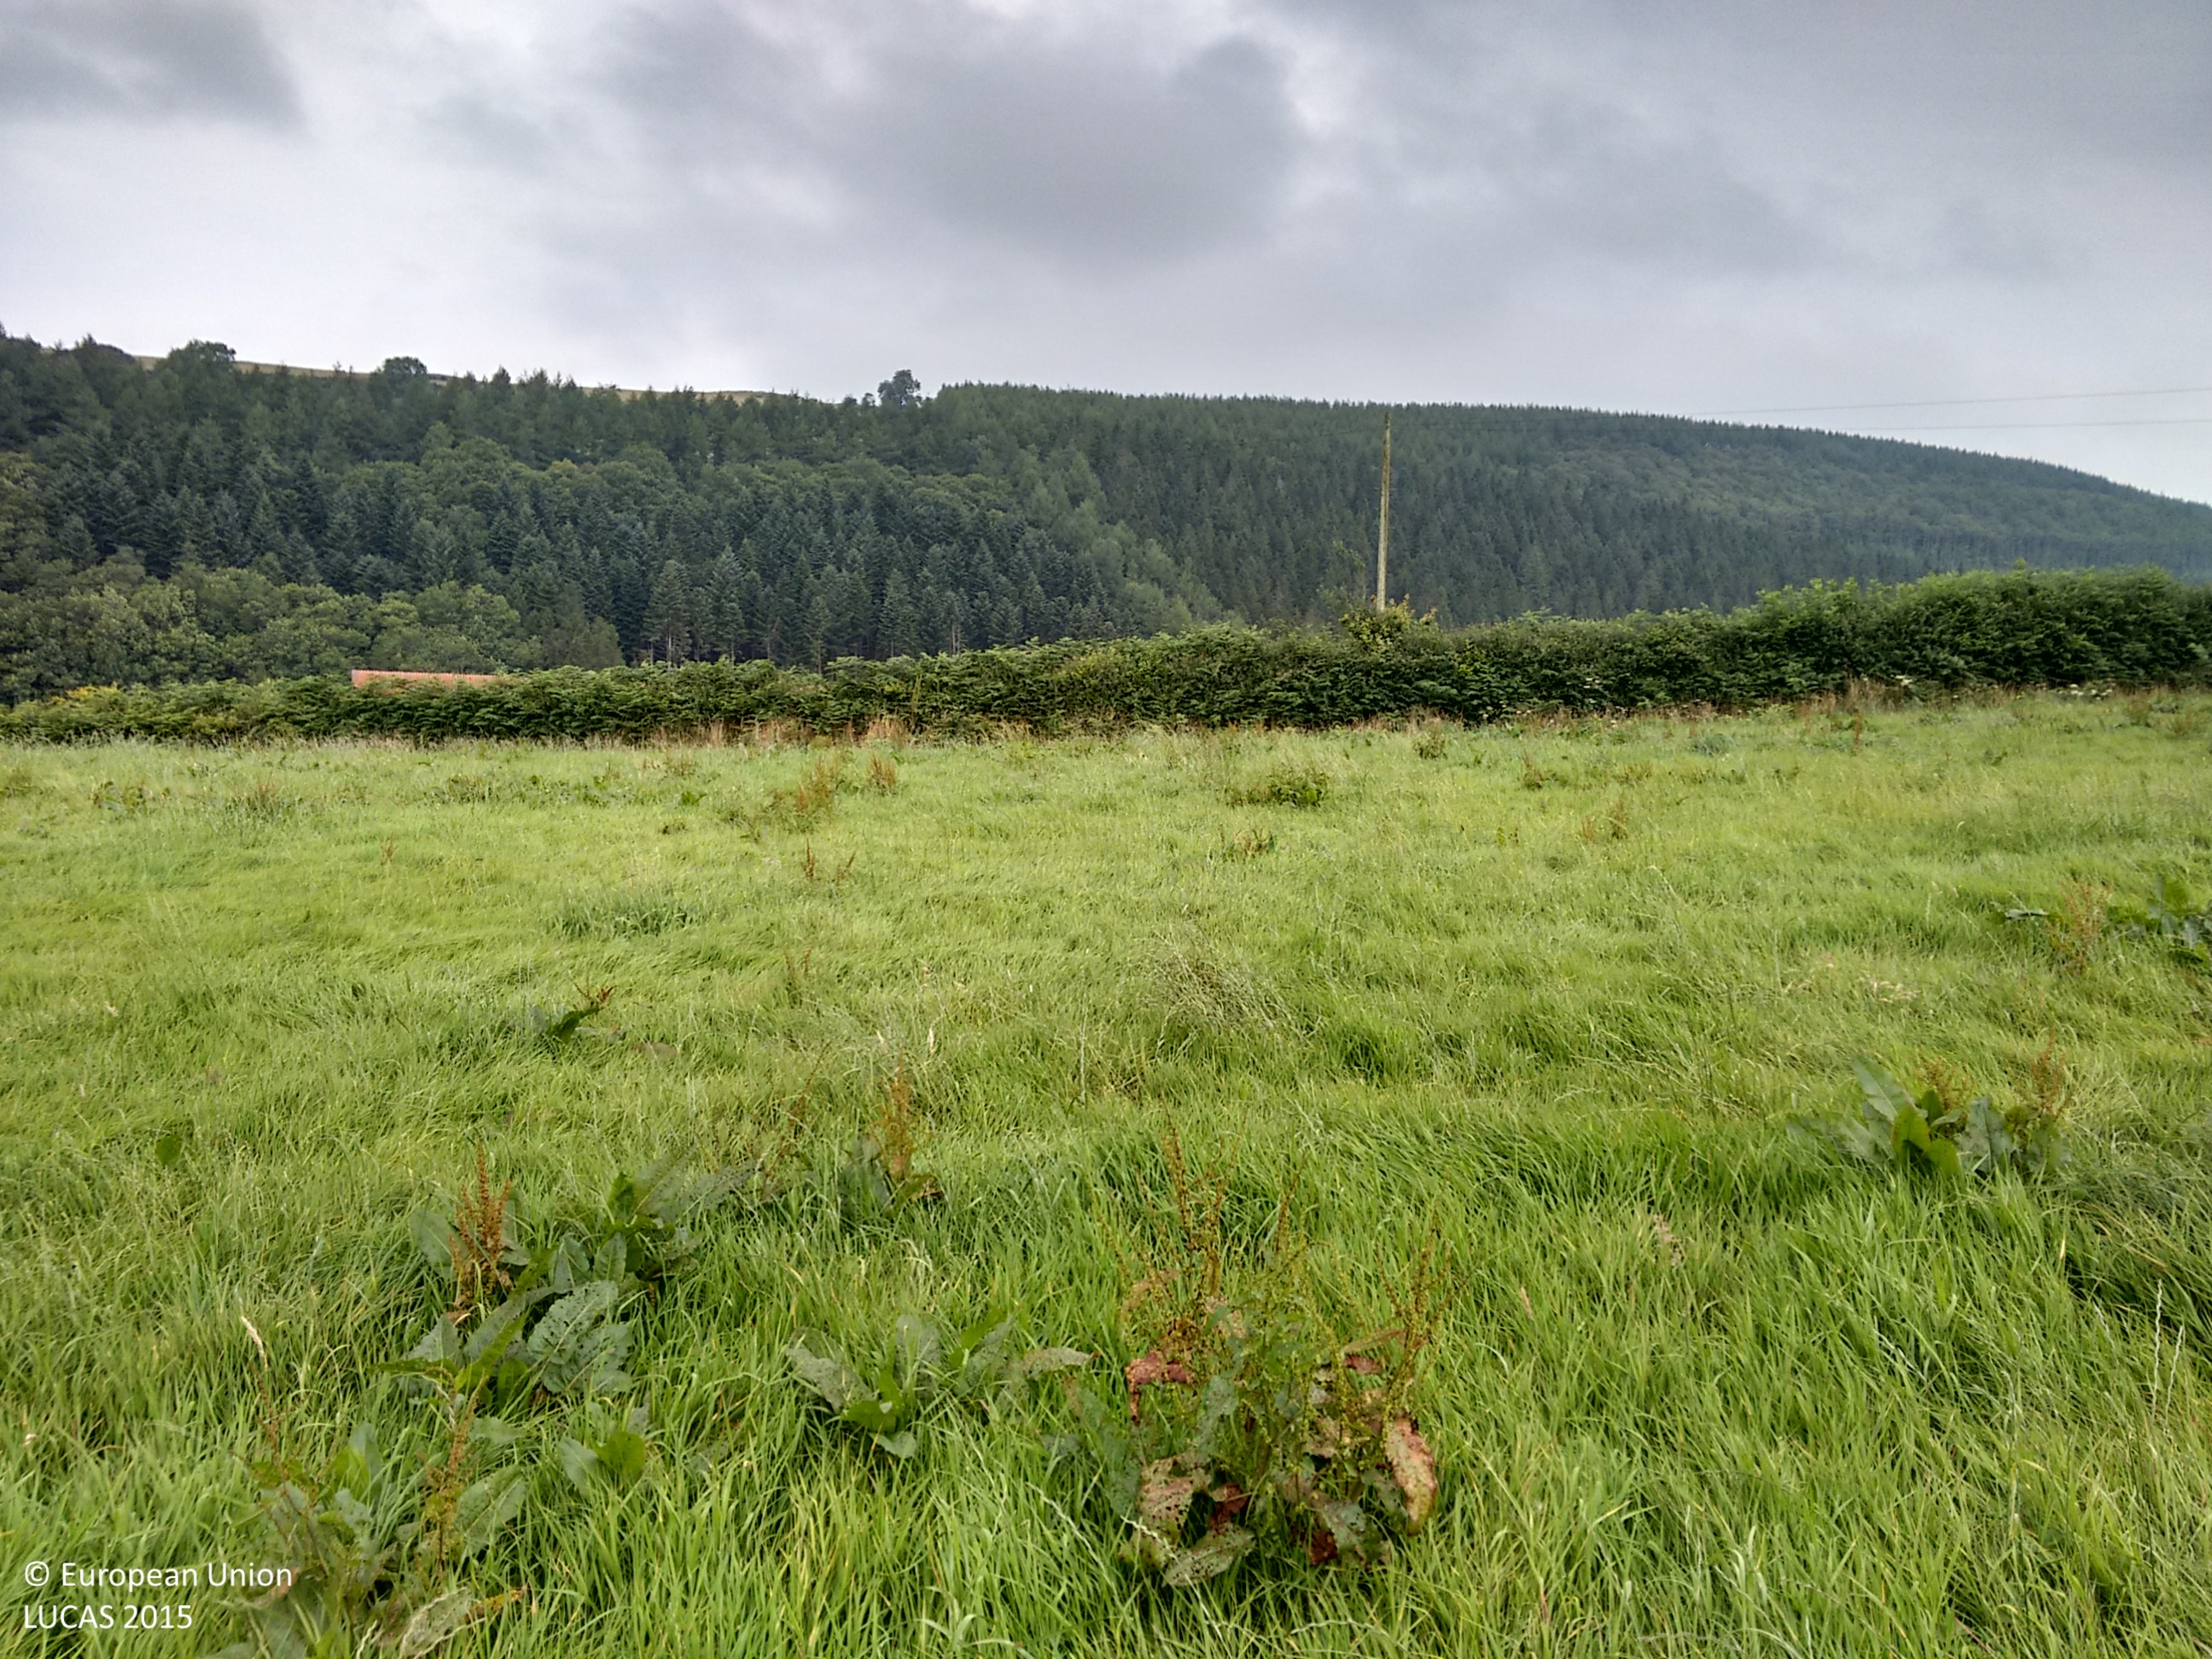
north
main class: Grassland
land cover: Grassland without tree/shrub cover
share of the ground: > 75 %
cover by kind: herbaceous plants 100 %
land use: Agriculture (excluding fallow land and kitchen gardens)
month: August
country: GB
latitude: 52.0437
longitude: -3.9296
